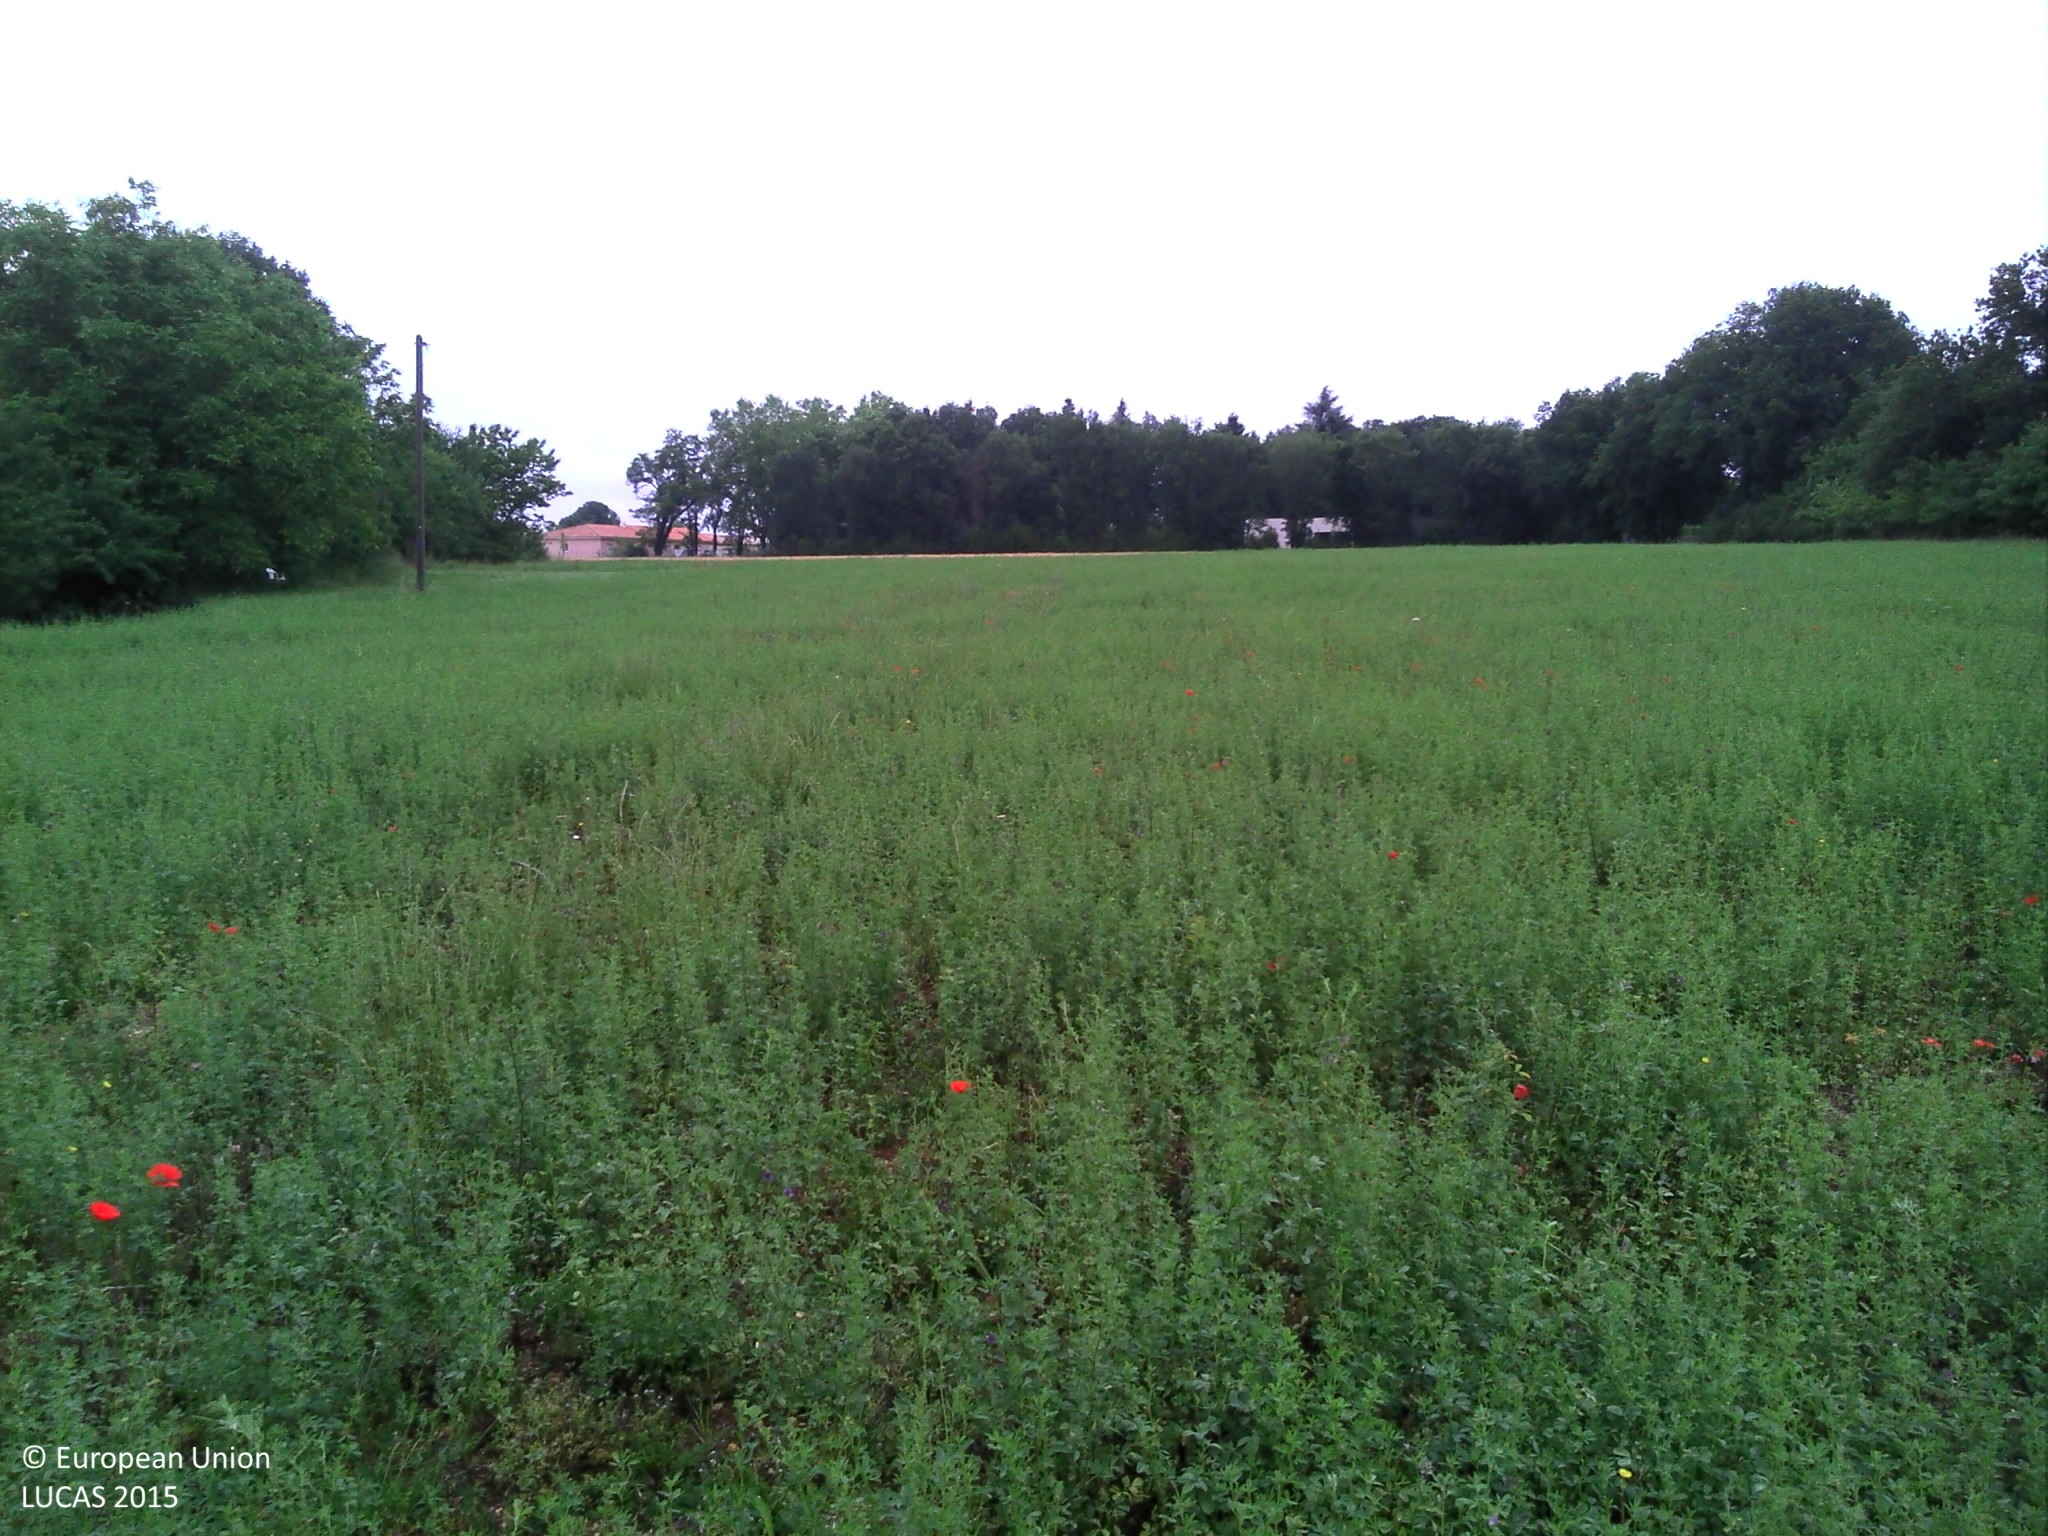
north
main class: Cropland
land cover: Lucerne
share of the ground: > 75 %
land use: Agriculture (excluding fallow land and kitchen gardens)
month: June
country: FR
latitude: 46.5596
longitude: 0.4727
